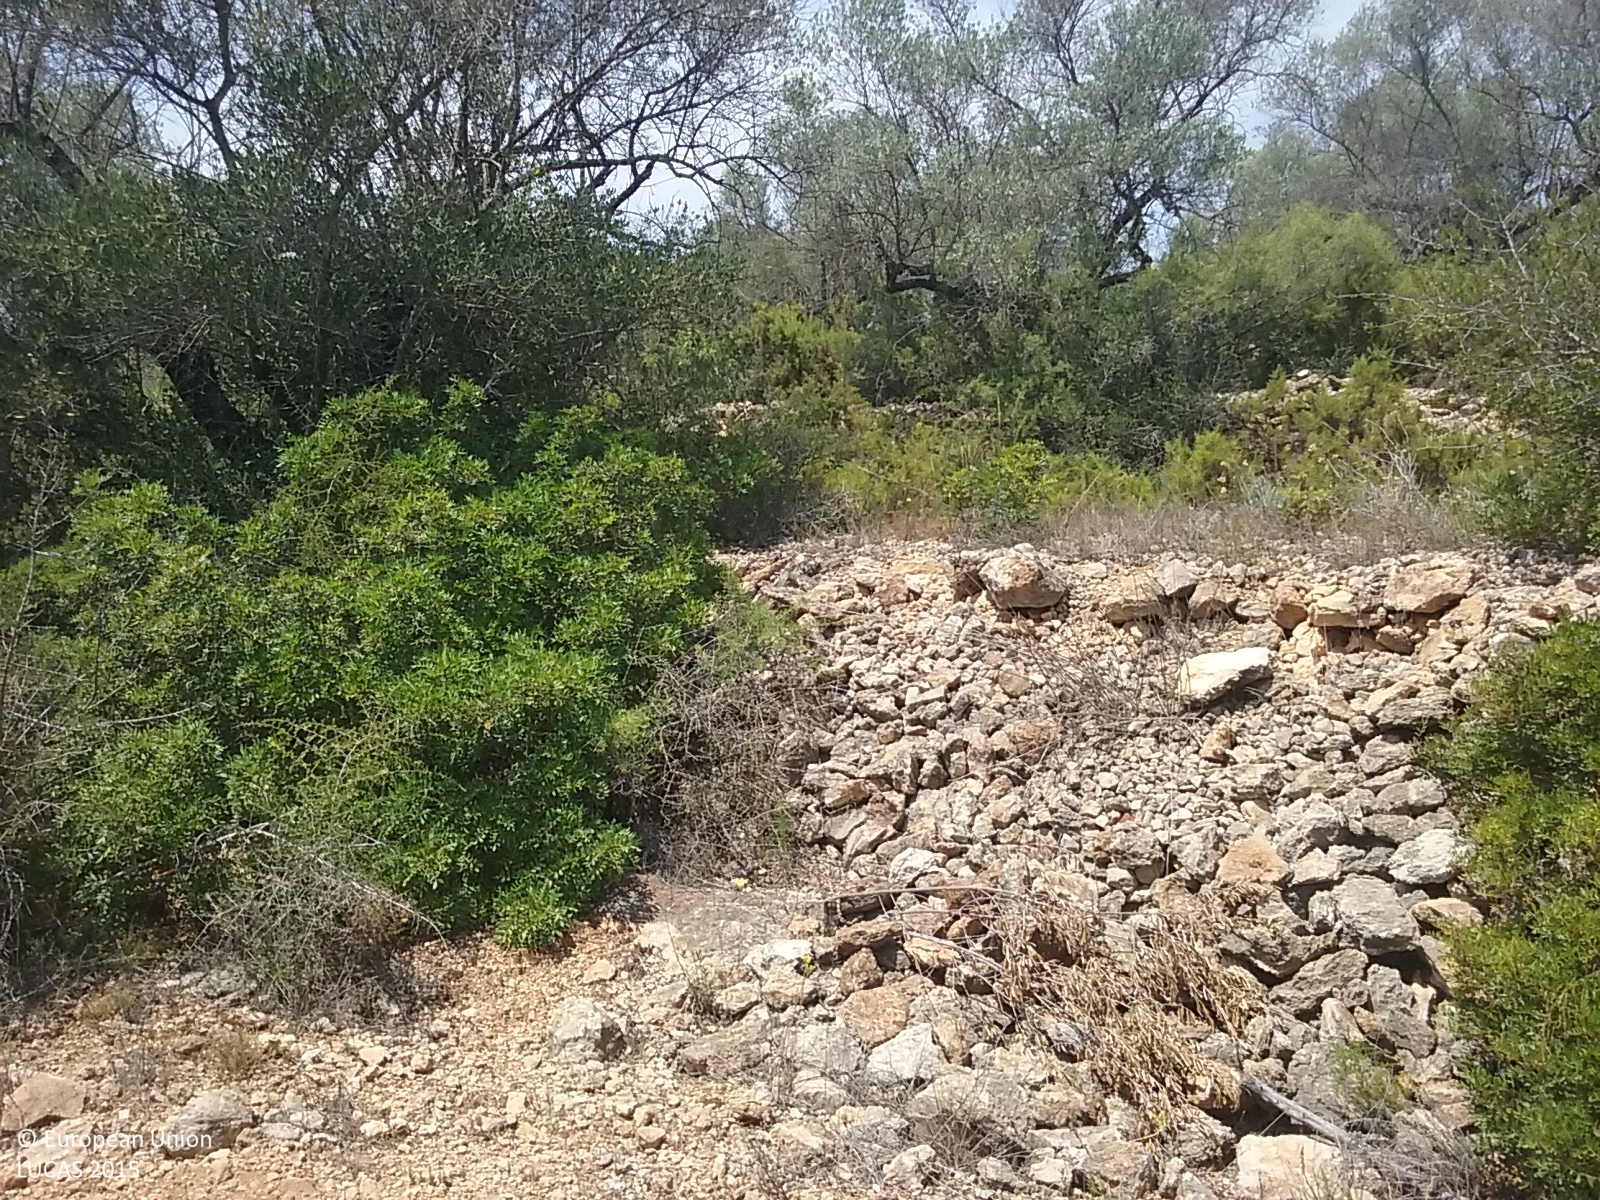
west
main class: Cropland
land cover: Olive groves
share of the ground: 25 - 50 %
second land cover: Grassland without tree/shrub cover
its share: 50 - 75 %
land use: Abandoned areas
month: July
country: ES
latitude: 40.1495
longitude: -0.0629
